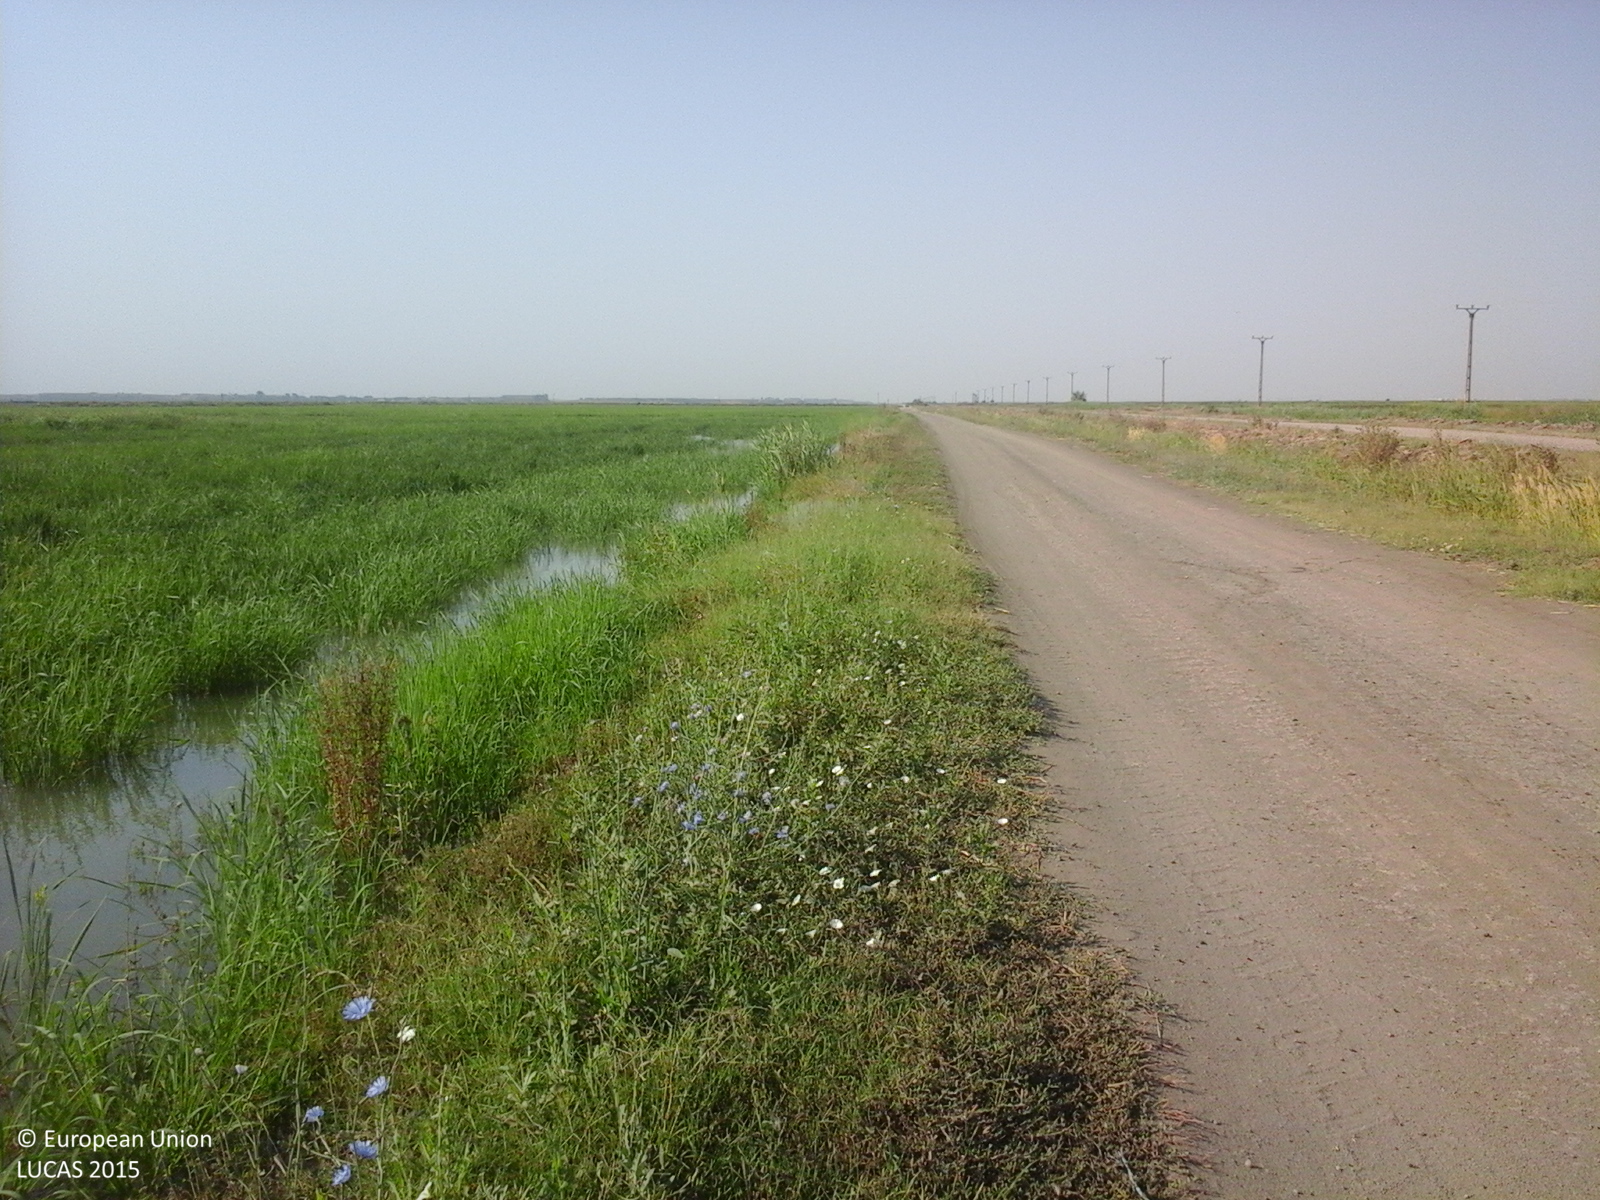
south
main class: Cropland
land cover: Rice
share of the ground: > 75 %
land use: Agriculture (excluding fallow land and kitchen gardens)
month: August
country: RO
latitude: 45.3733
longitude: 27.8216
